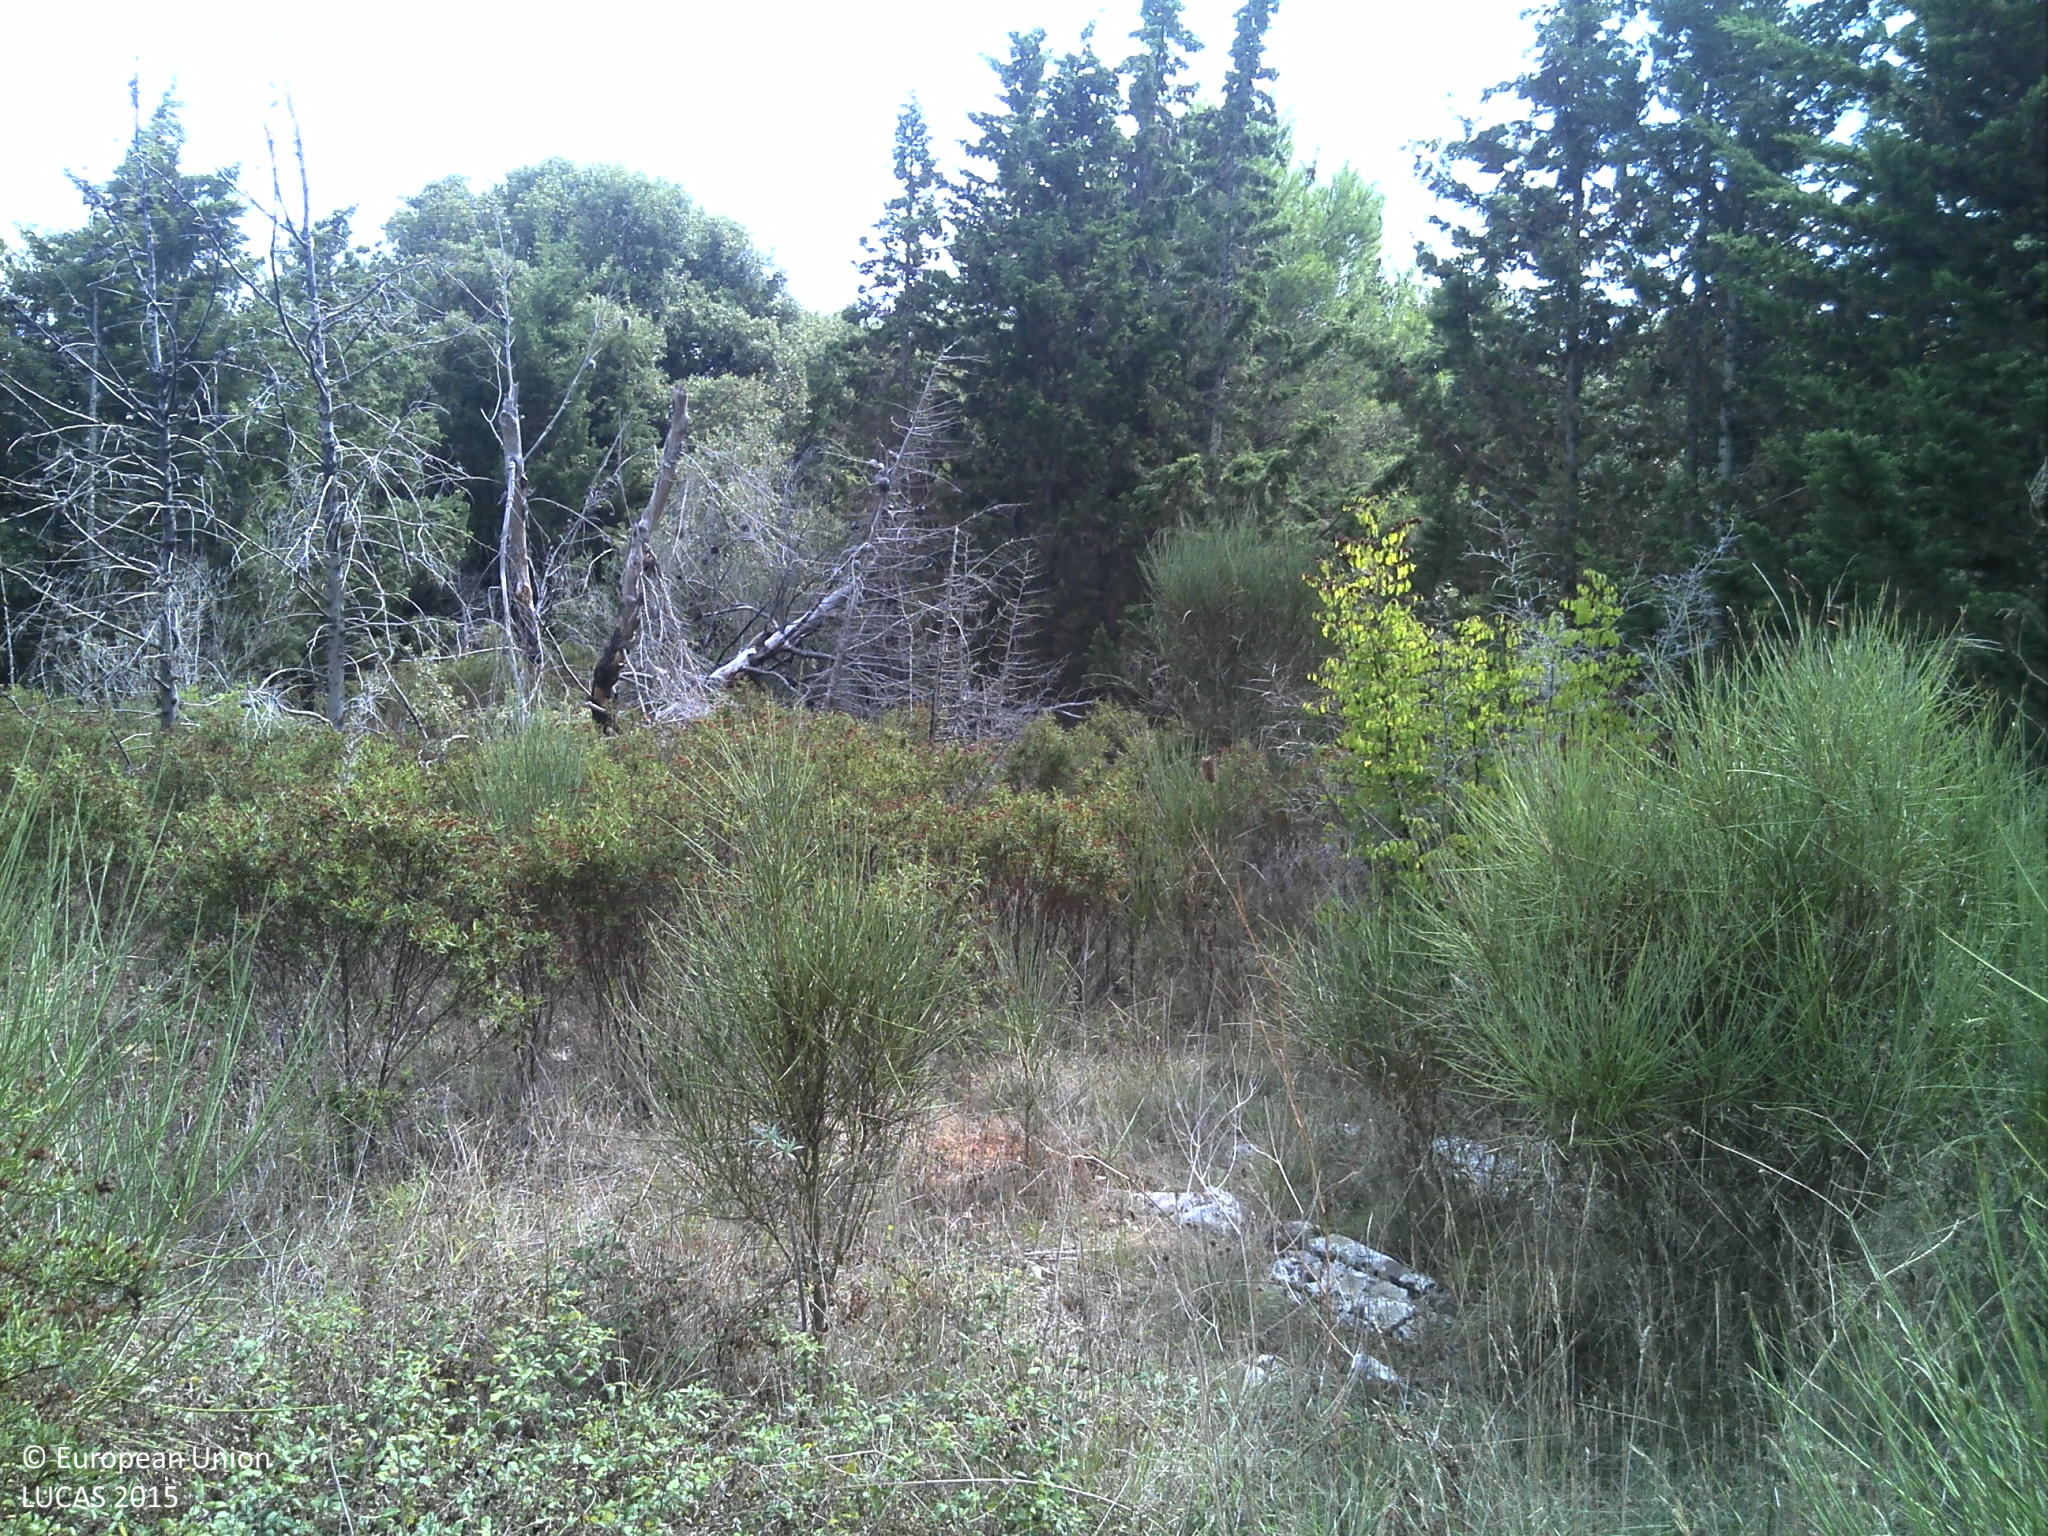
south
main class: Shrubland
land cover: Shrubland with sparse tree cover
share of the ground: 50 - 75 %
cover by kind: shrubs 65 %, herbaceous plants 30 %, coniferous forest trees 5 %
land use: Abandoned areas
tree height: > 5 m
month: September
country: HR
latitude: 44.1358
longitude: 15.0793
